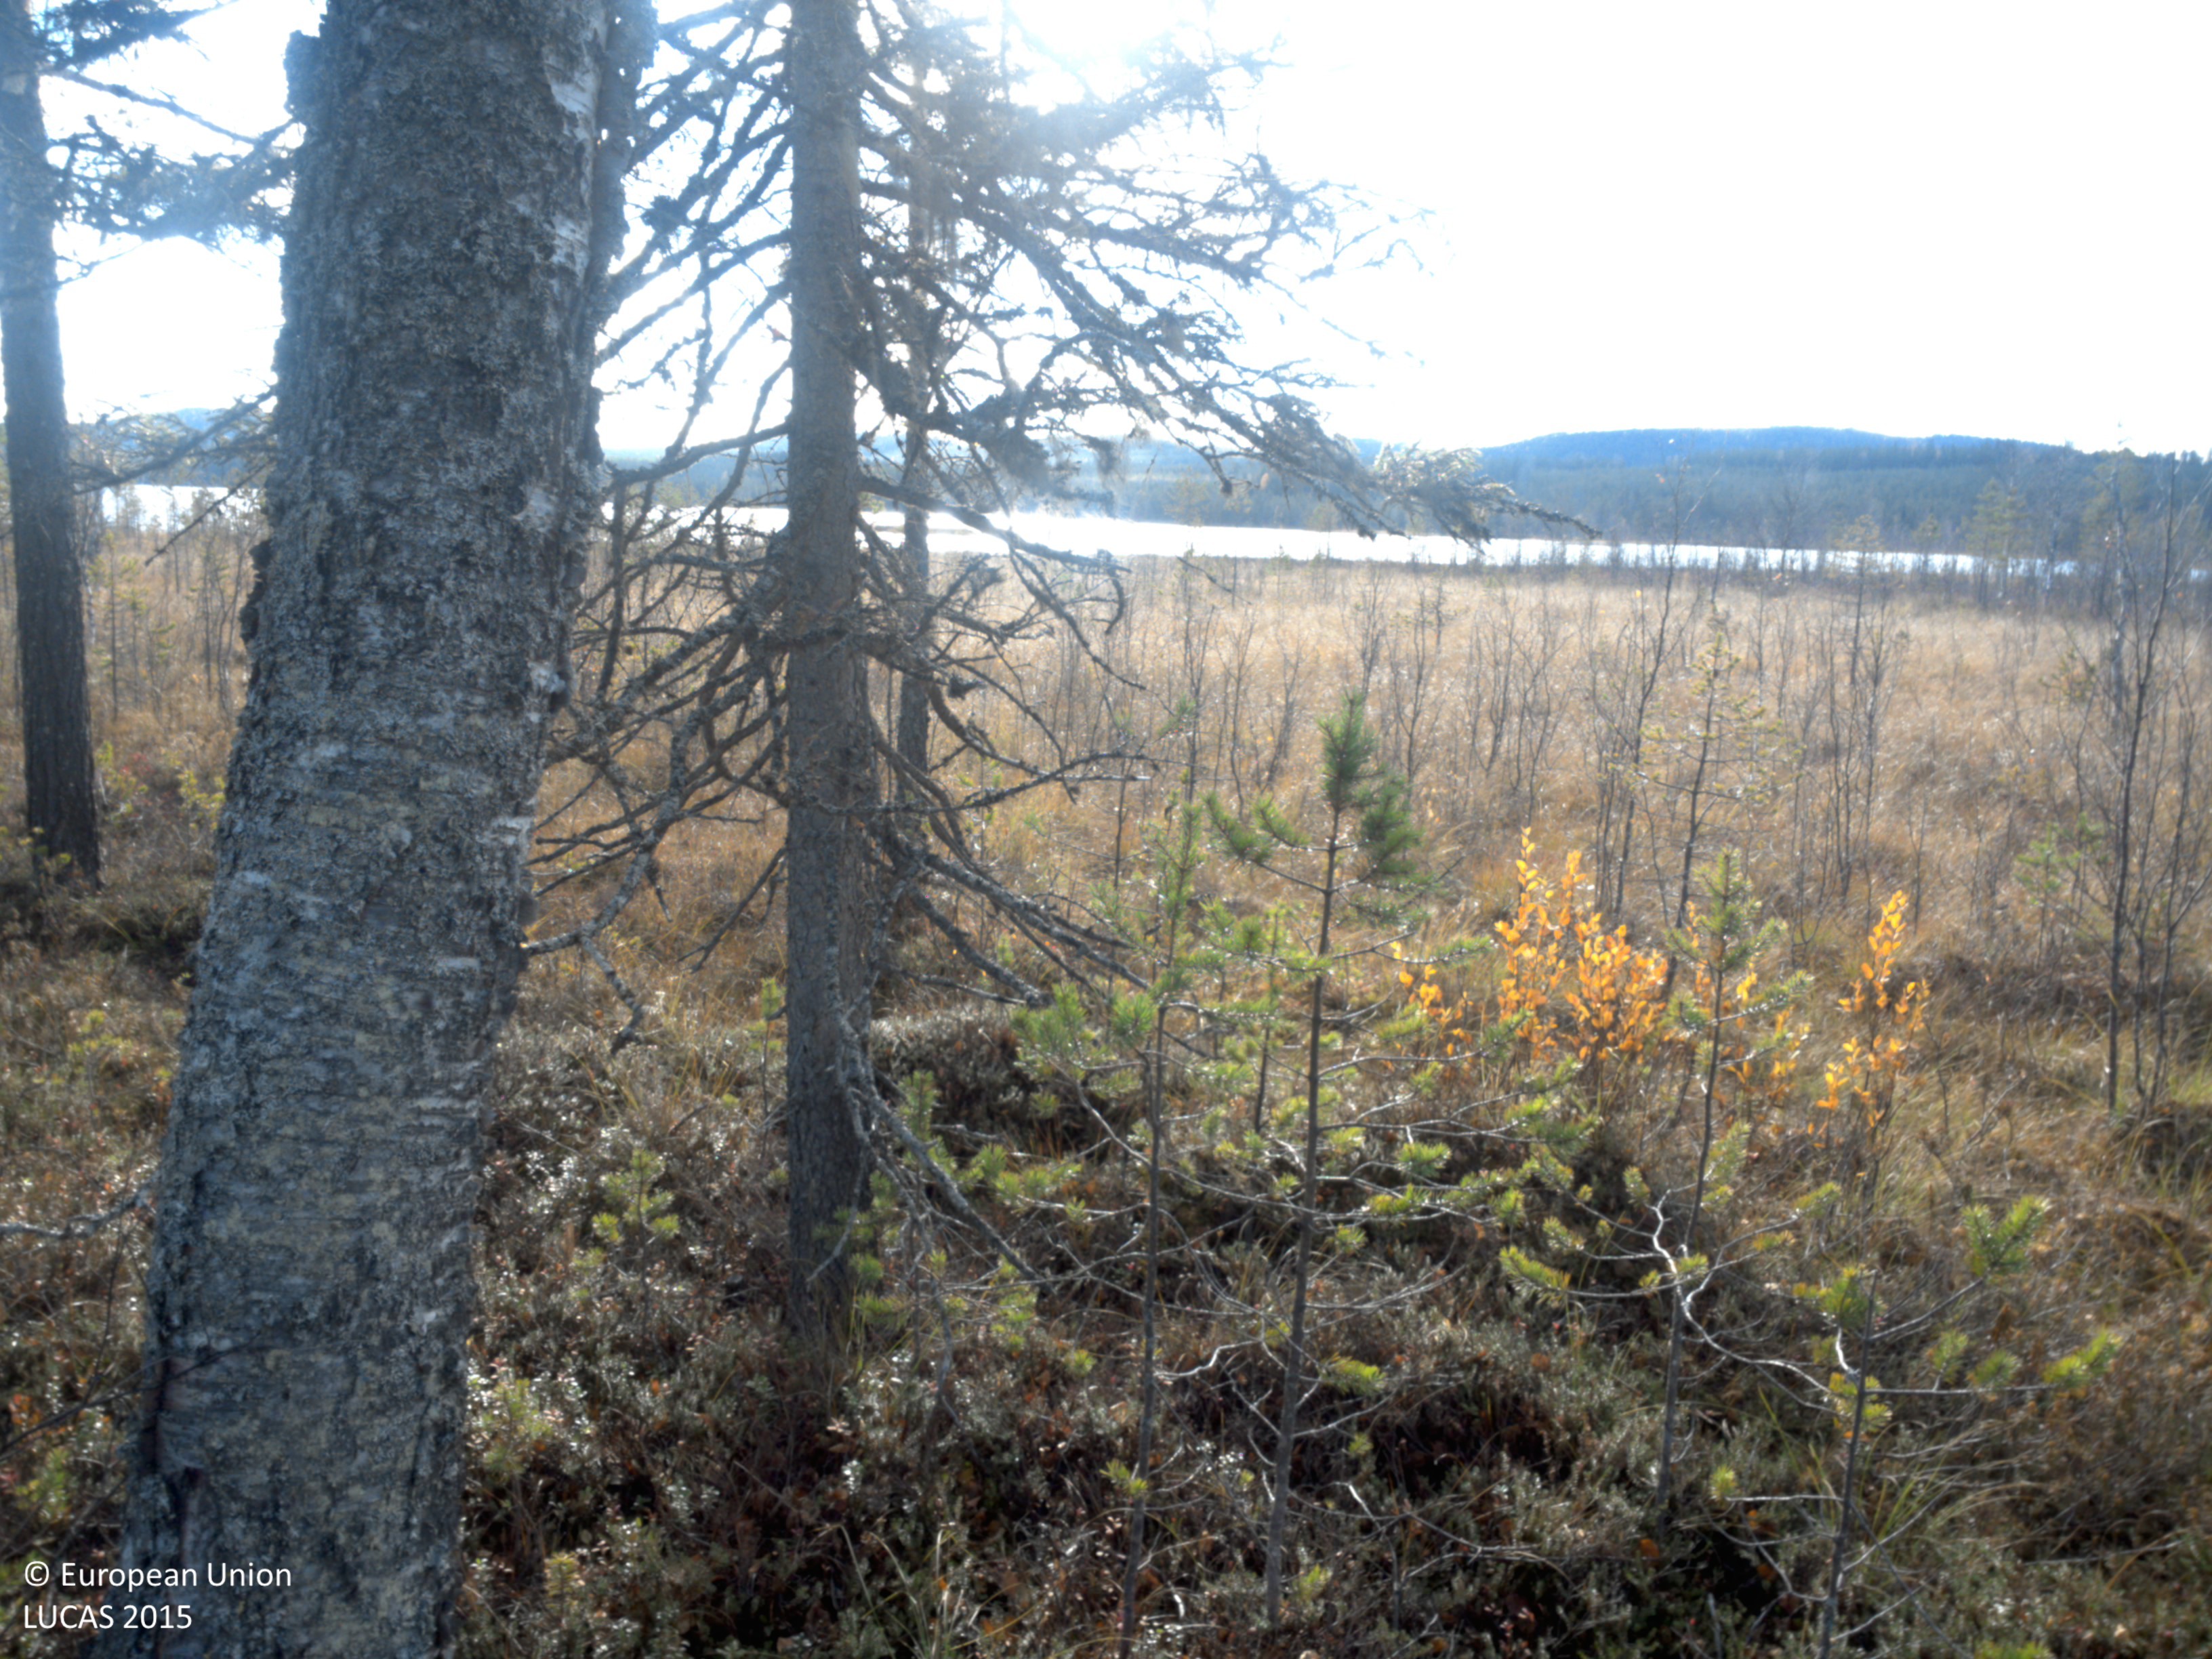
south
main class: Woodland
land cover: Pine dominated mixed woodland
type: boreal forest
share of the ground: 25 - 50 %
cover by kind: shrubs 35 %, herbaceous plants 20 %, coniferous forest trees 15 %, broadleaved forest trees 15 %, lichens and mosses 15 %
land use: Forestry
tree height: > 5 m
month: October
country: SE
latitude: 64.7733
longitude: 18.4406
